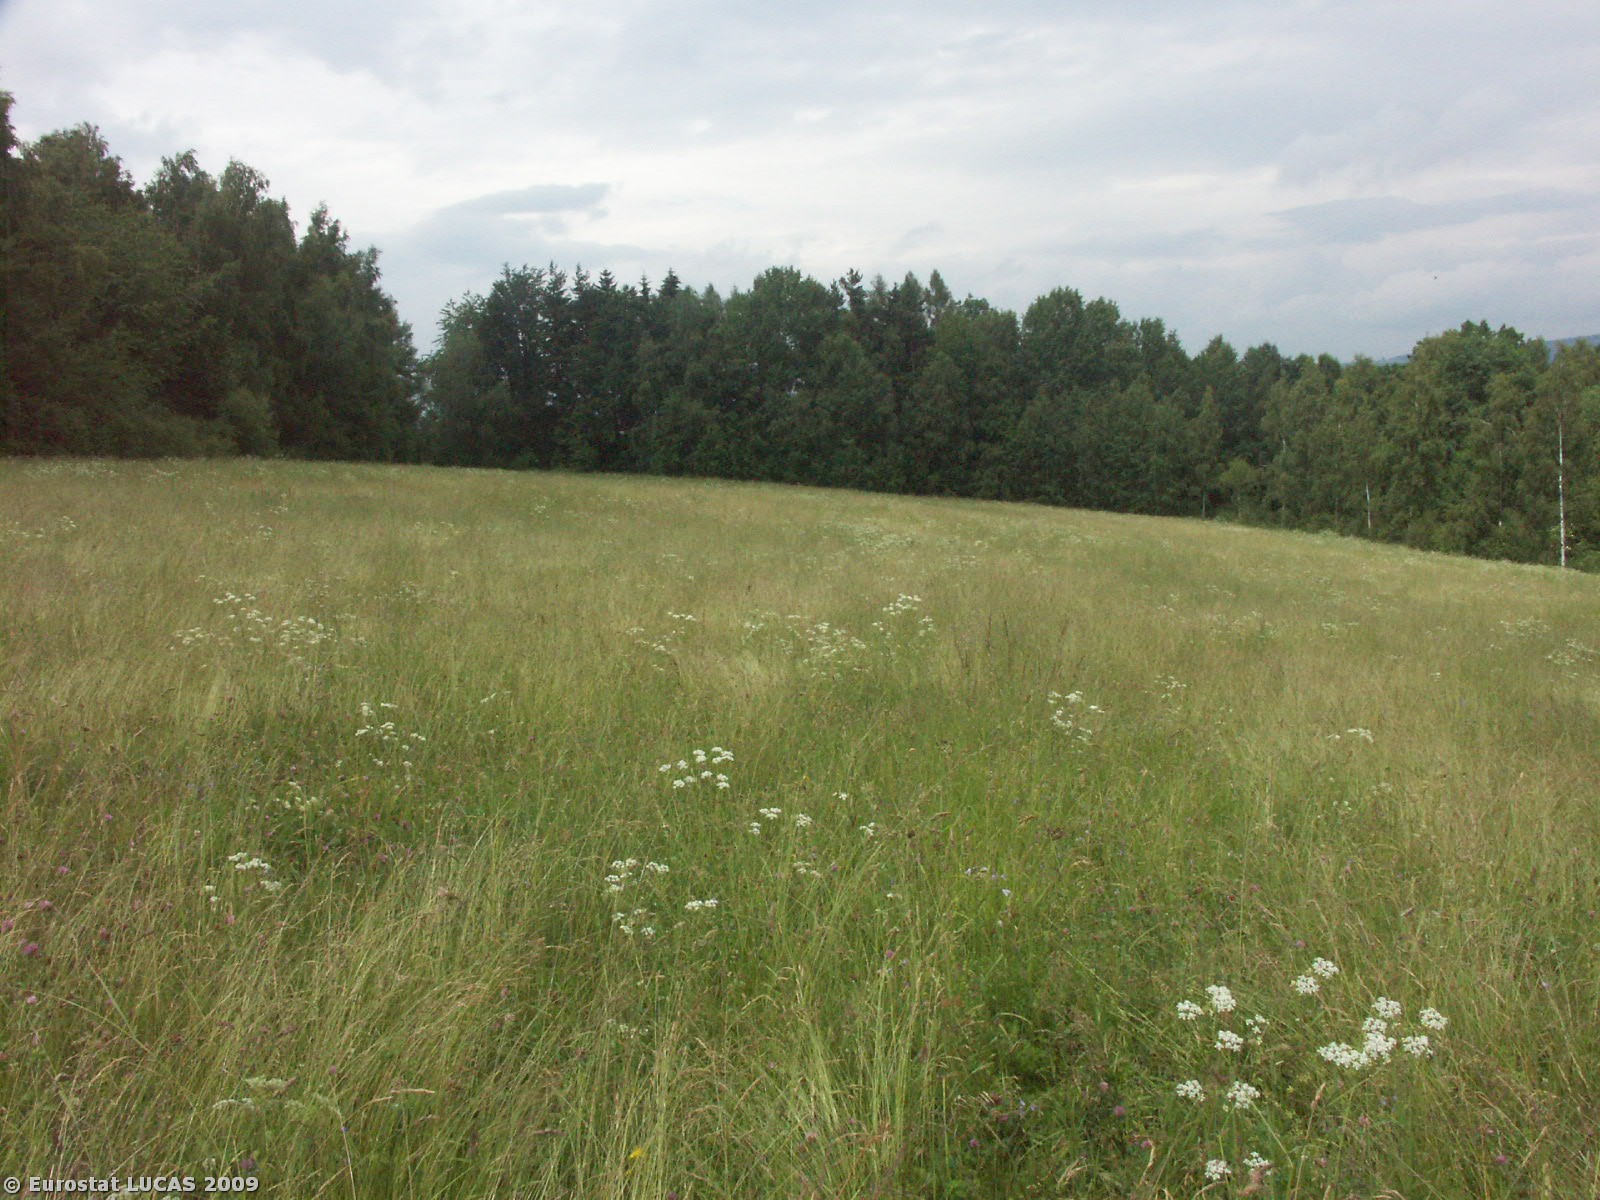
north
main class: Grassland
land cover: Grassland without tree/shrub cover
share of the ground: > 75 %
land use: Agriculture (excluding fallow land and kitchen gardens)
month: June
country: CZ
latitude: 48.7159
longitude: 14.3091
